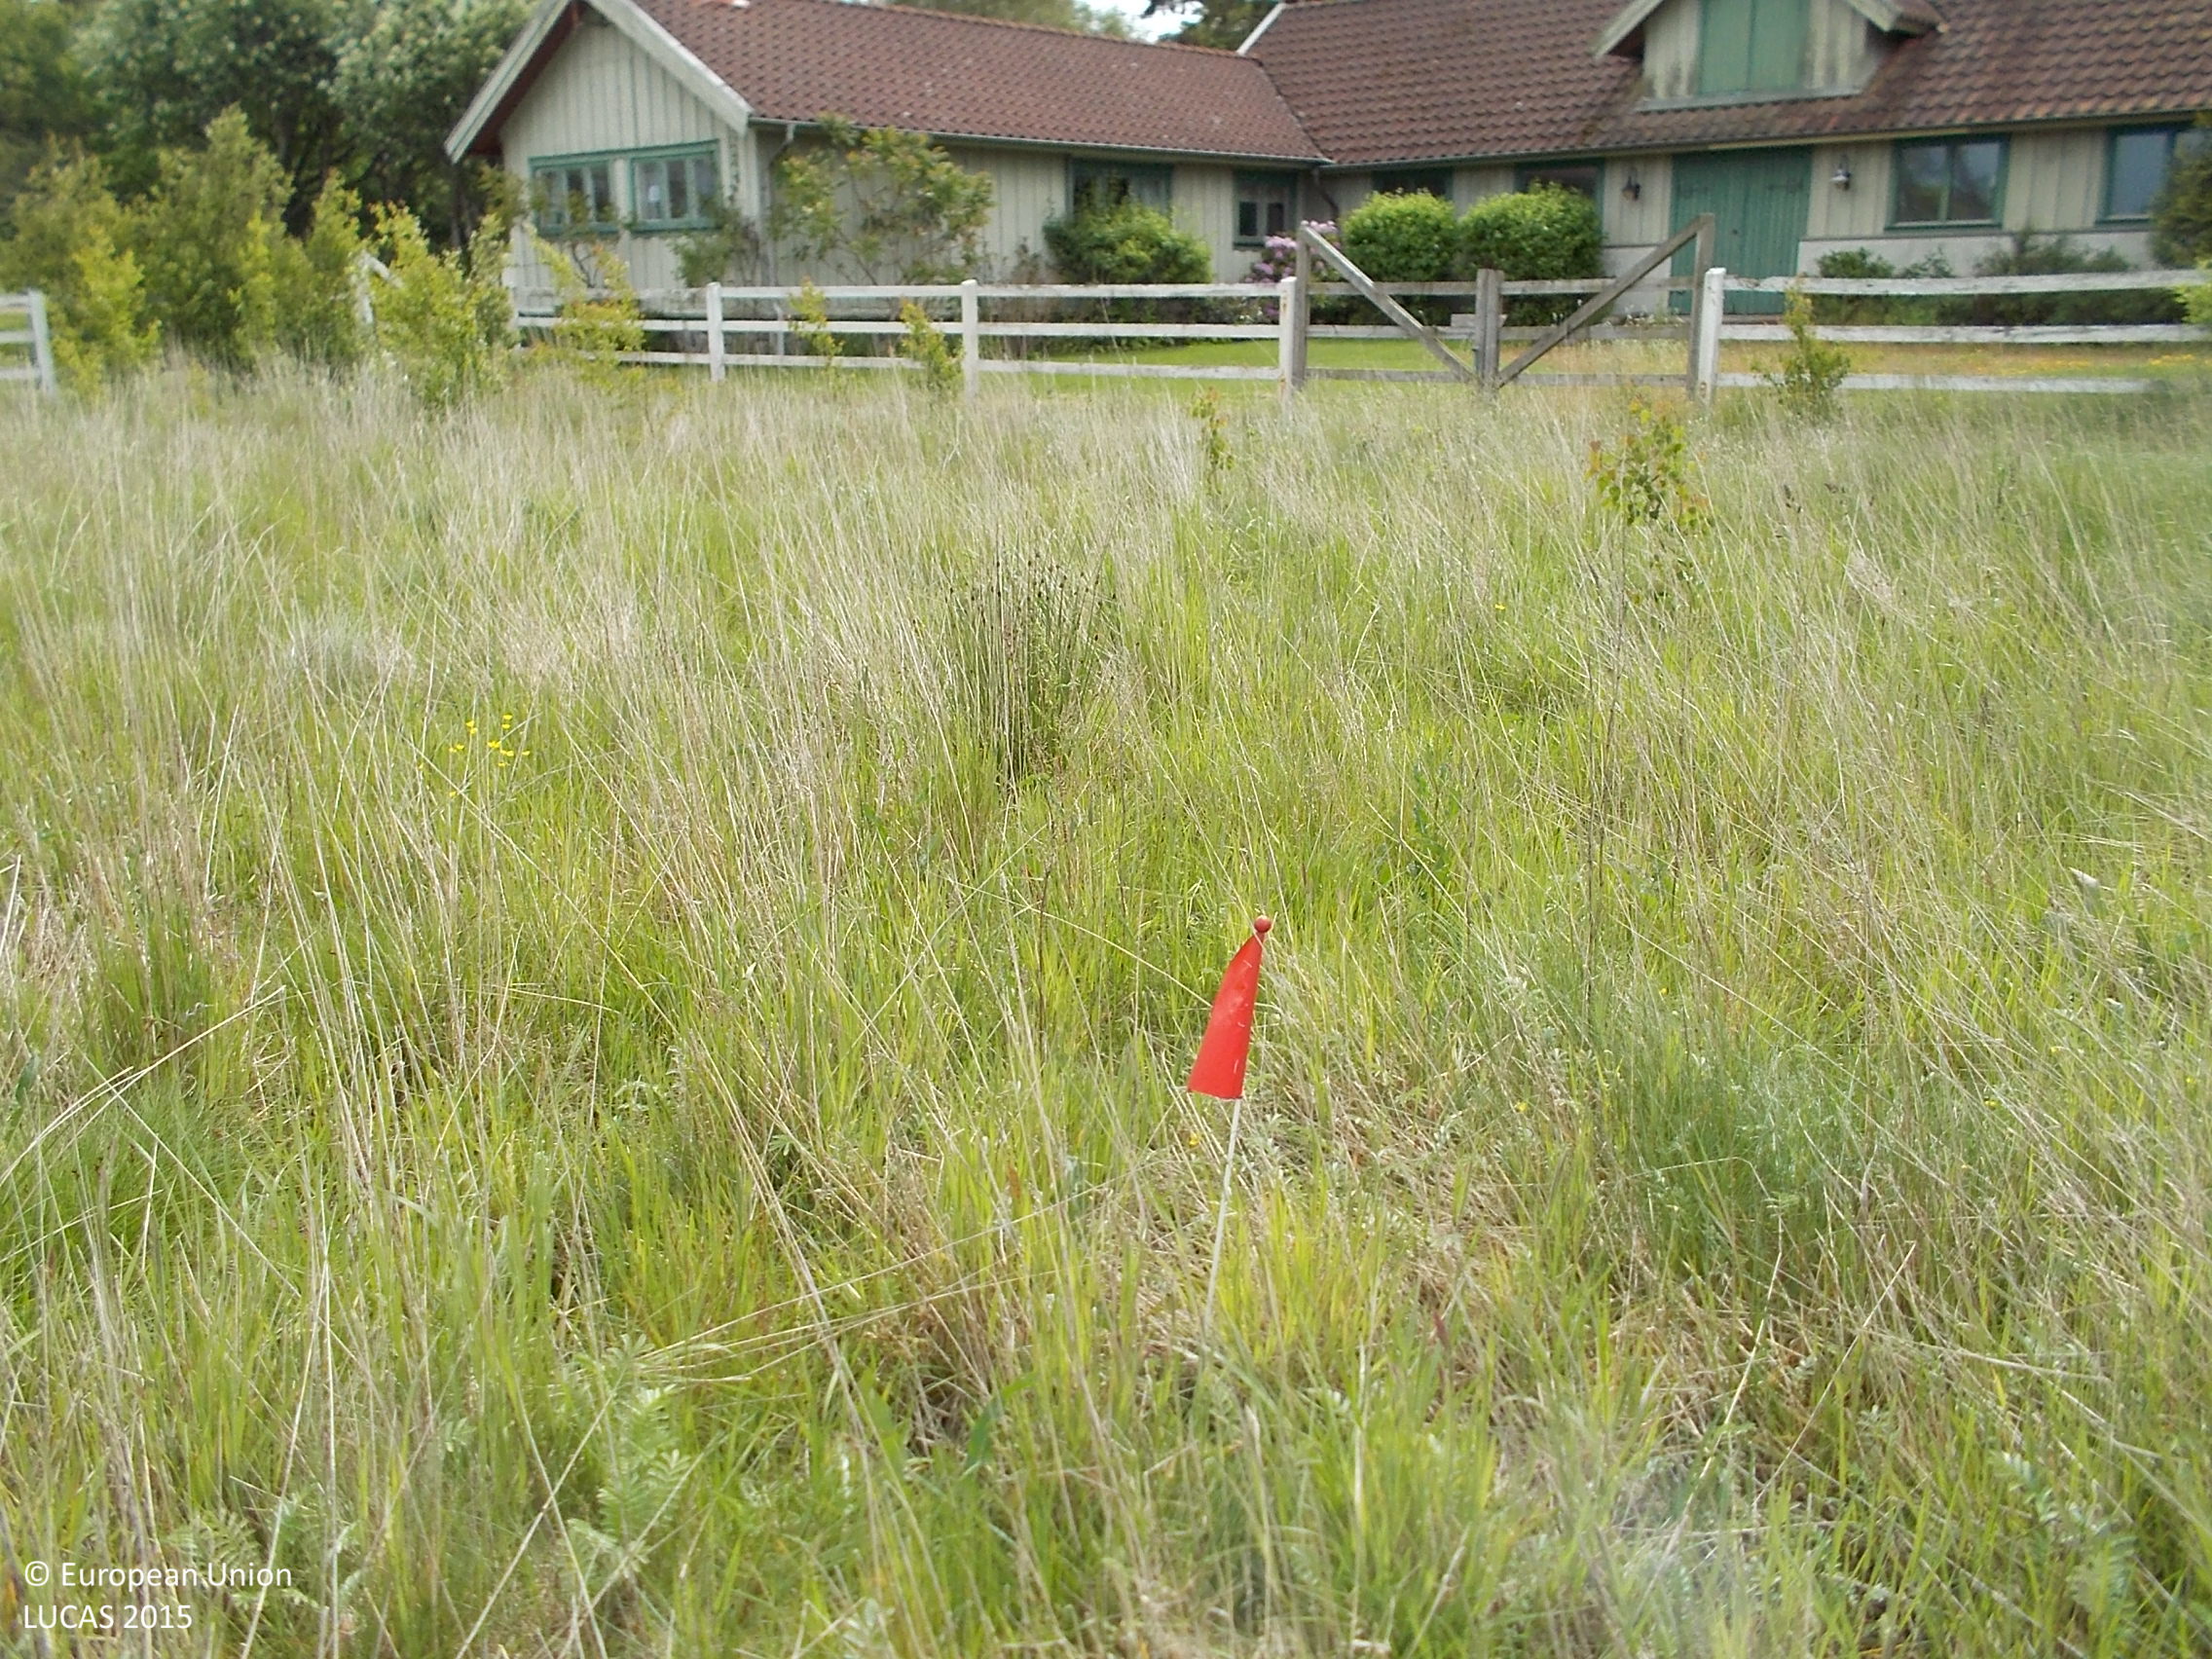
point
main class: Grassland
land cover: Grassland with sparse tree/shrub cover
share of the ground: > 75 %
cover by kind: herbaceous plants 90 %, broadleaved forest trees 5 %, shrubs 5 %
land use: Abandoned areas
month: June
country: SE
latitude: 57.3959
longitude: 11.9439
